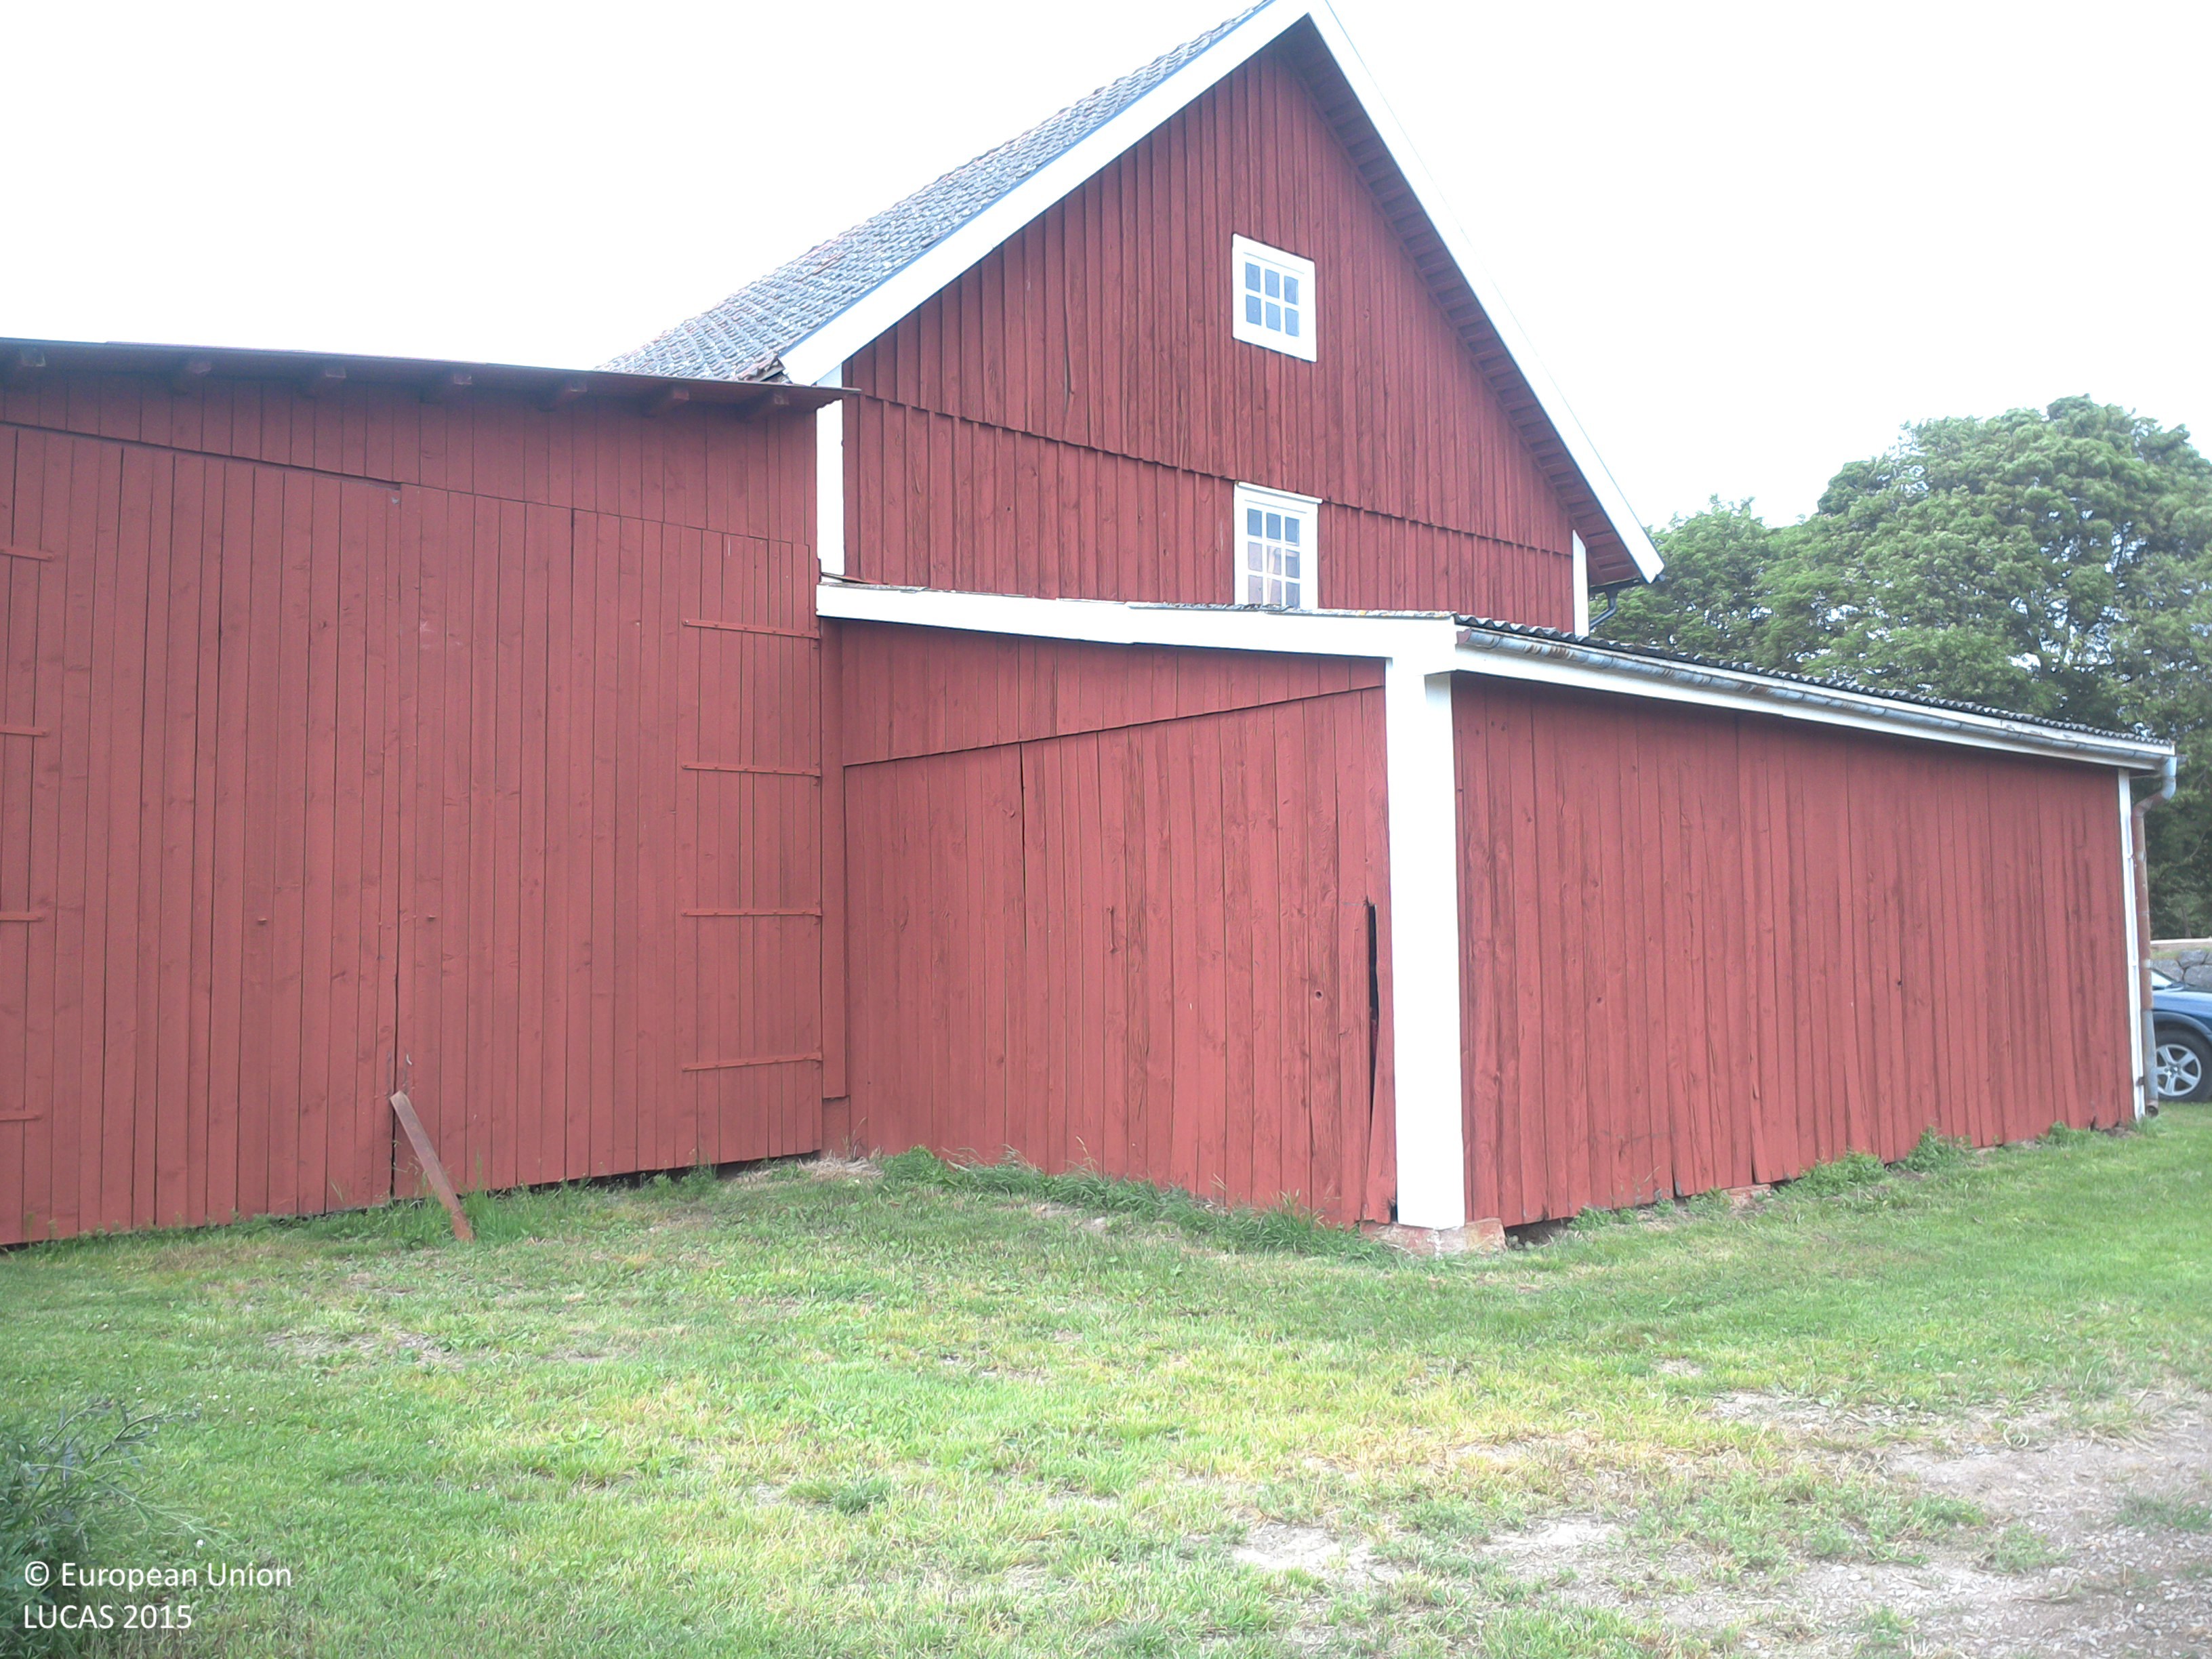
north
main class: Cropland
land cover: Common wheat
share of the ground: > 75 %
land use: Agriculture (excluding fallow land and kitchen gardens)
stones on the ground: < 10 %
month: July
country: SE
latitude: 58.5018
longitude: 15.0903
